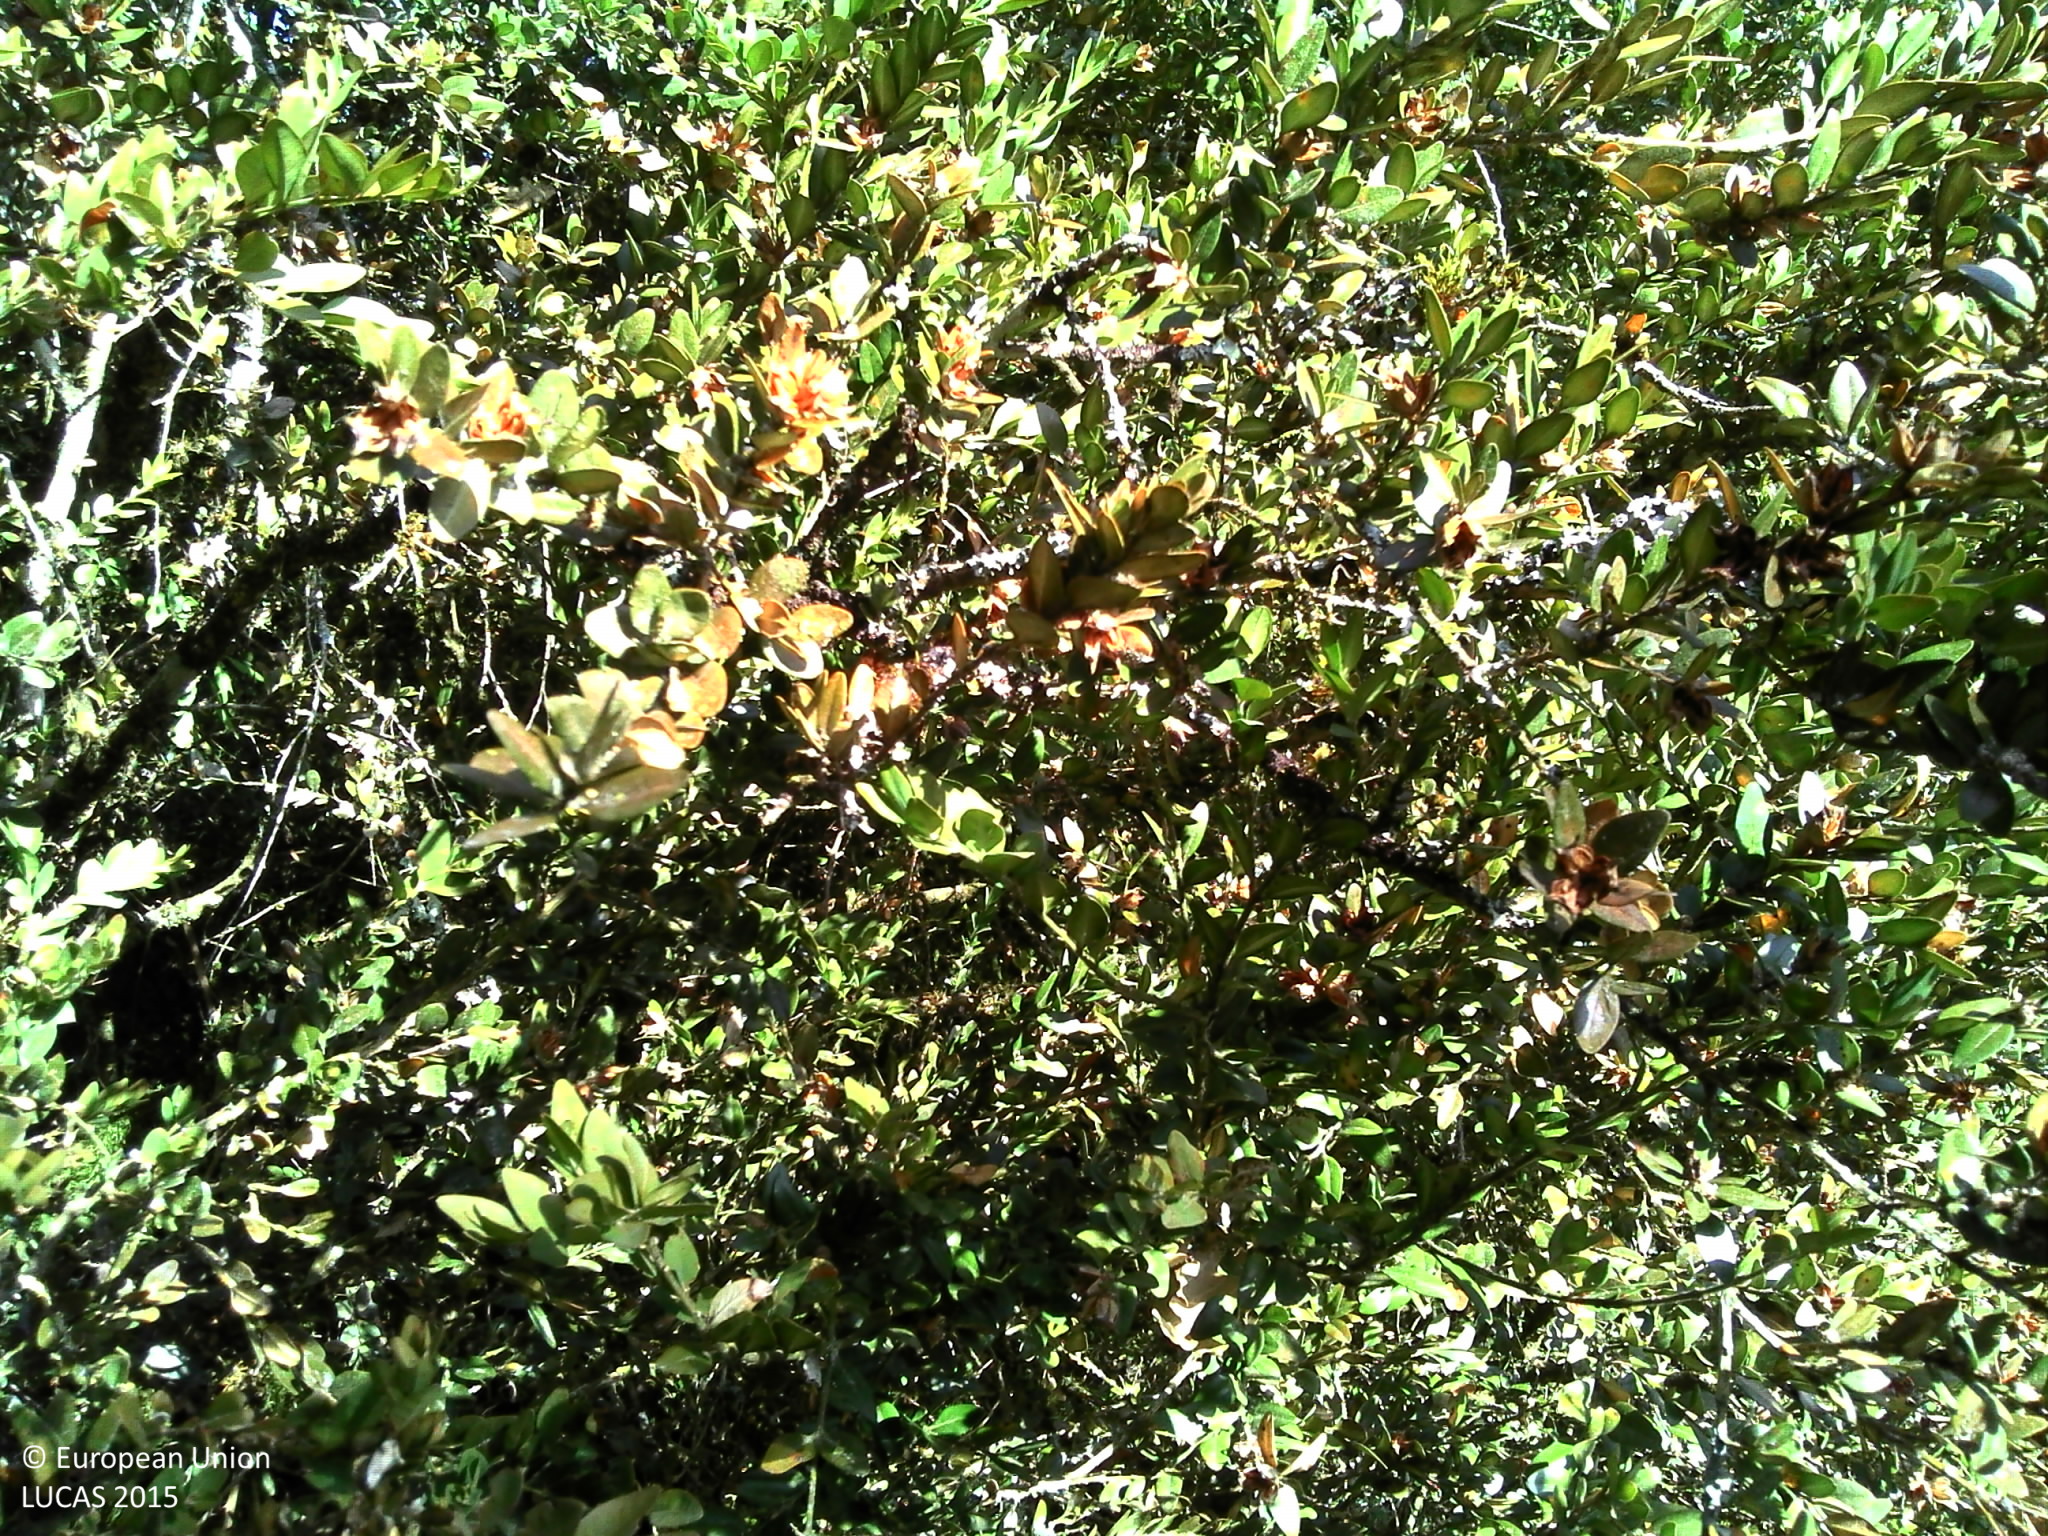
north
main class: Woodland
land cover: Broadleaved woodland
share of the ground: > 75 %
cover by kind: broadleaved forest trees 70 %, herbaceous plants 15 %, shrubs 10 %, lichens and mosses 5 %
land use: Forestry
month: August
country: FR
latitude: 43.8871
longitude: 3.1235
